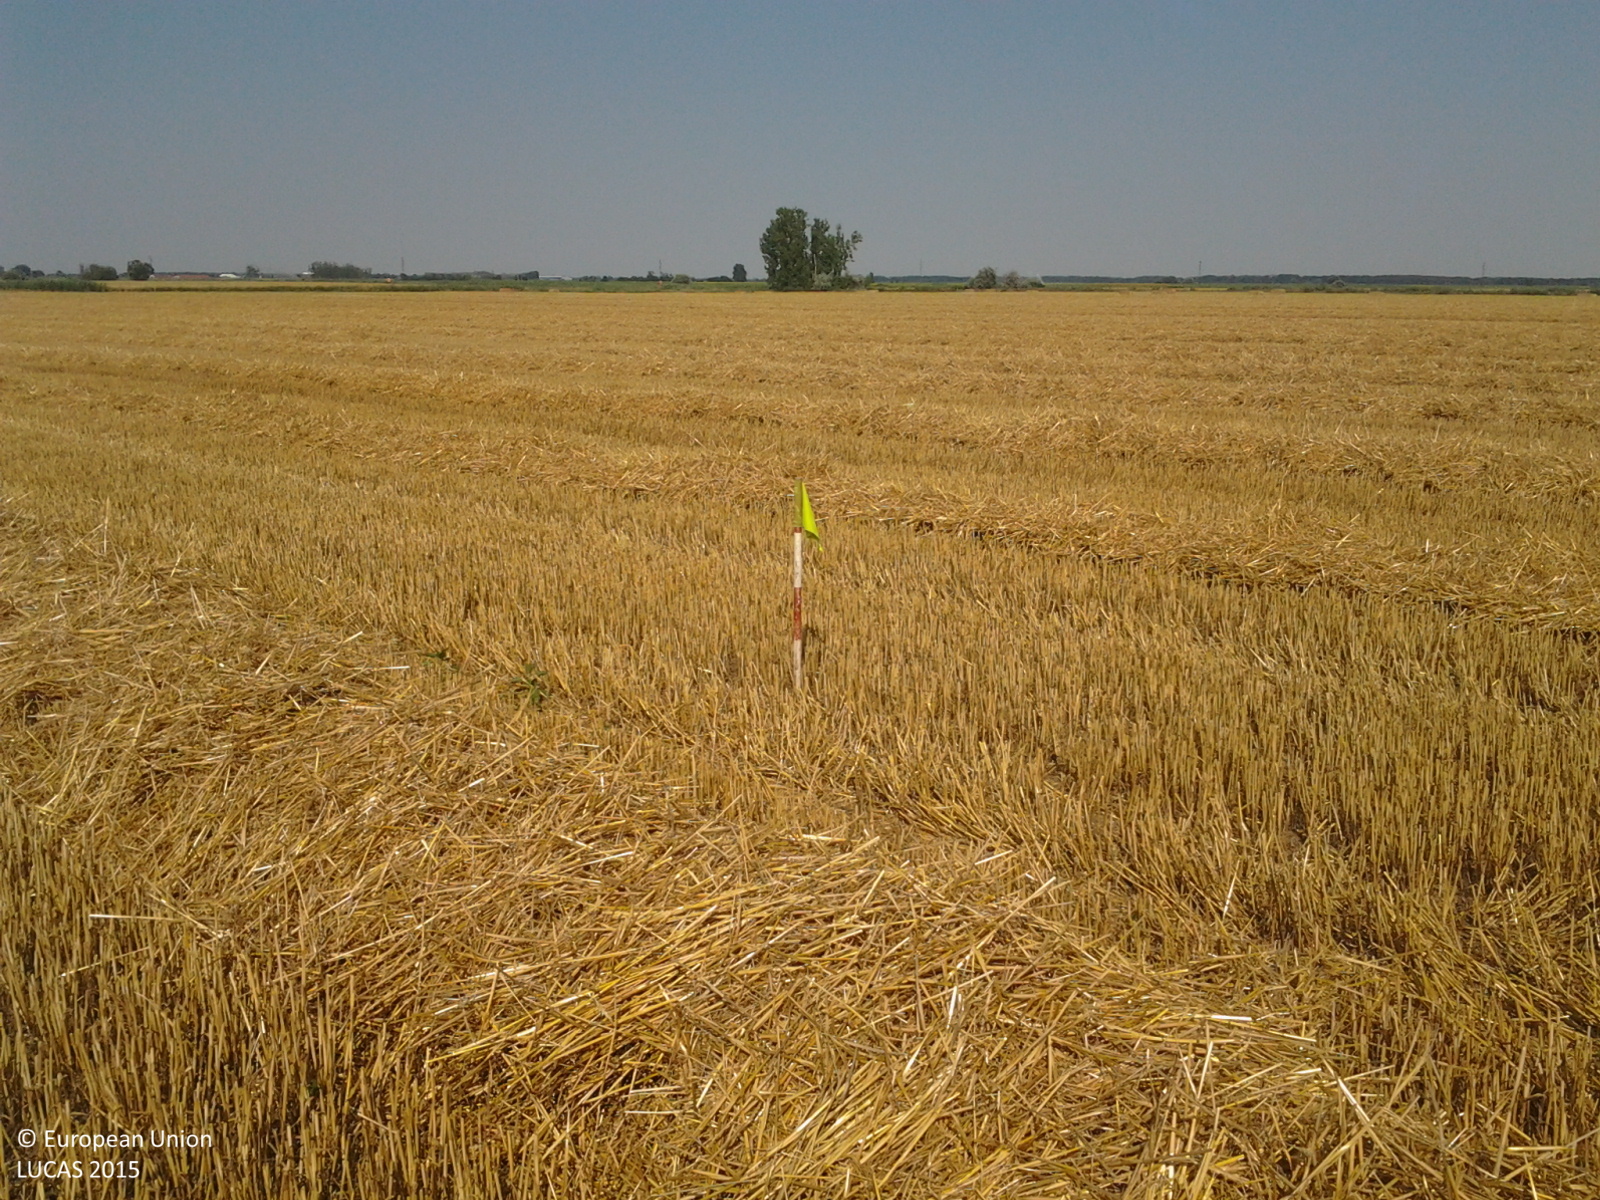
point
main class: Cropland
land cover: Triticale
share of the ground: > 75 %
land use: Agriculture (excluding fallow land and kitchen gardens)
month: July
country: HU
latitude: 47.4654
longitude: 19.9353
